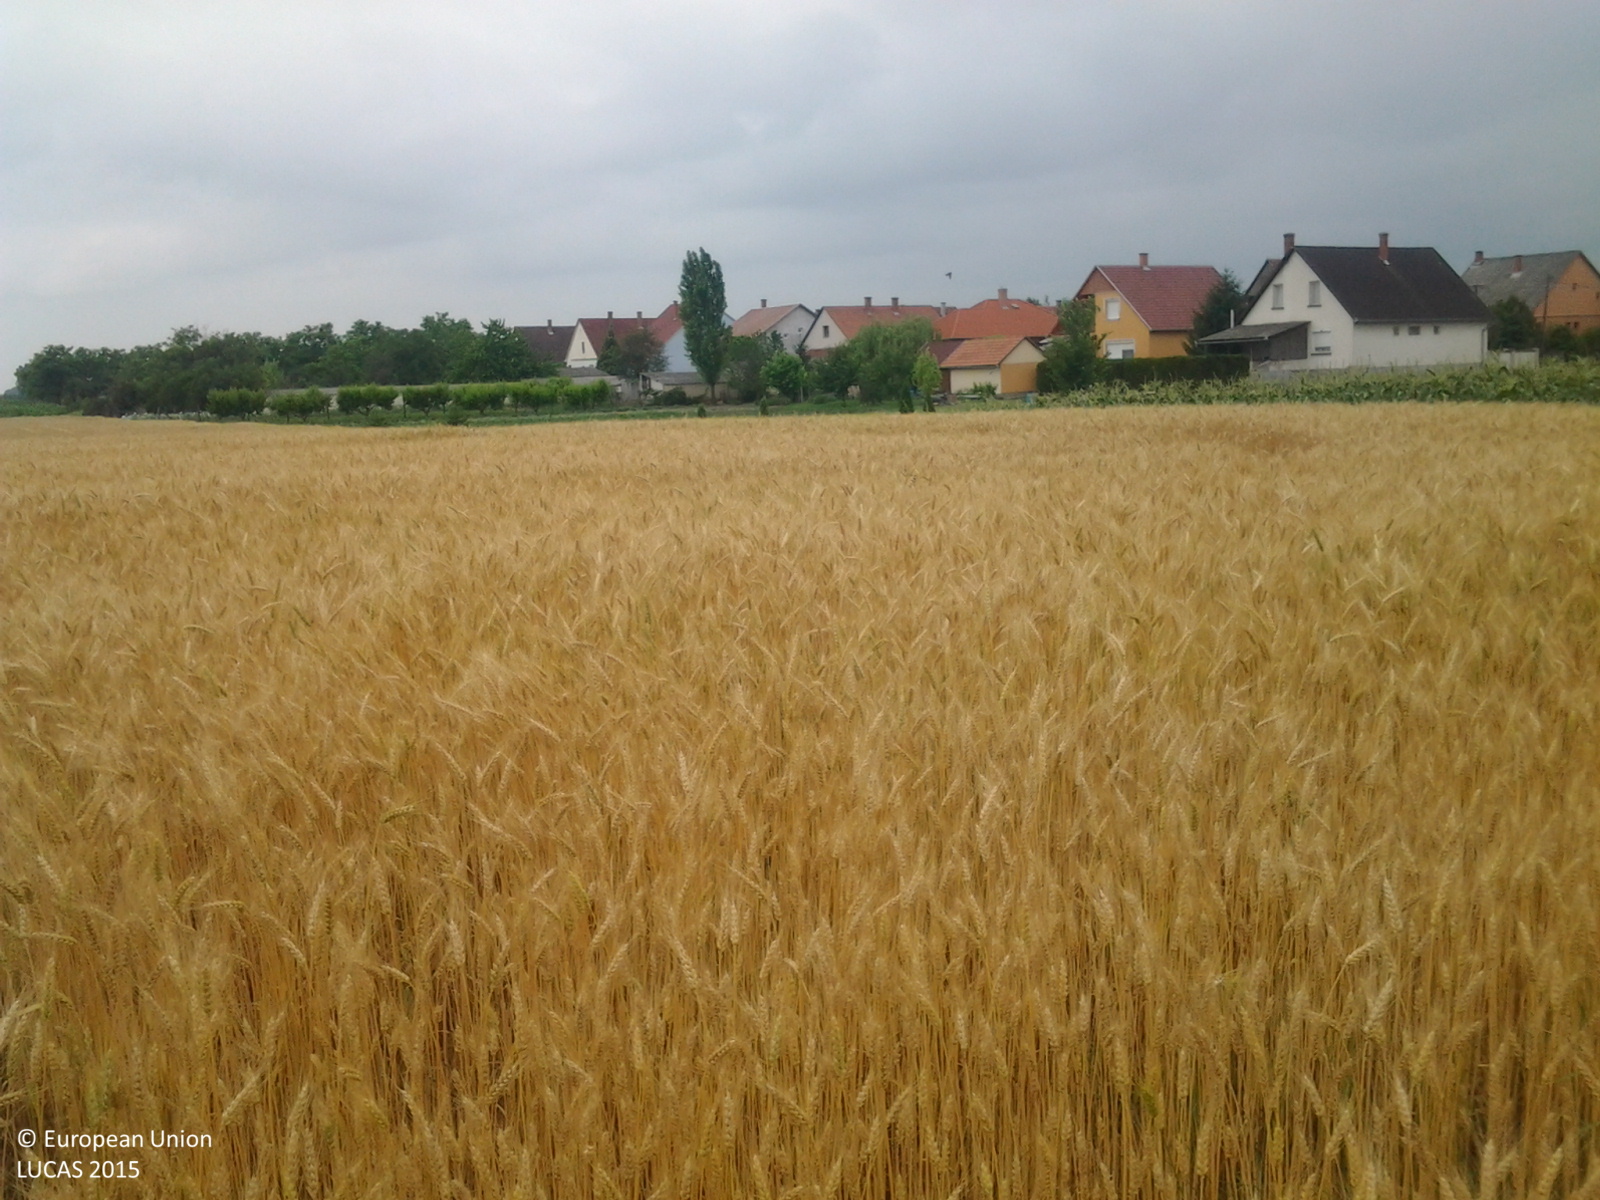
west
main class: Cropland
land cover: Common wheat
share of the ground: > 75 %
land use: Agriculture (excluding fallow land and kitchen gardens)
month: June
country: HU
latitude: 46.4394
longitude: 19.0336
